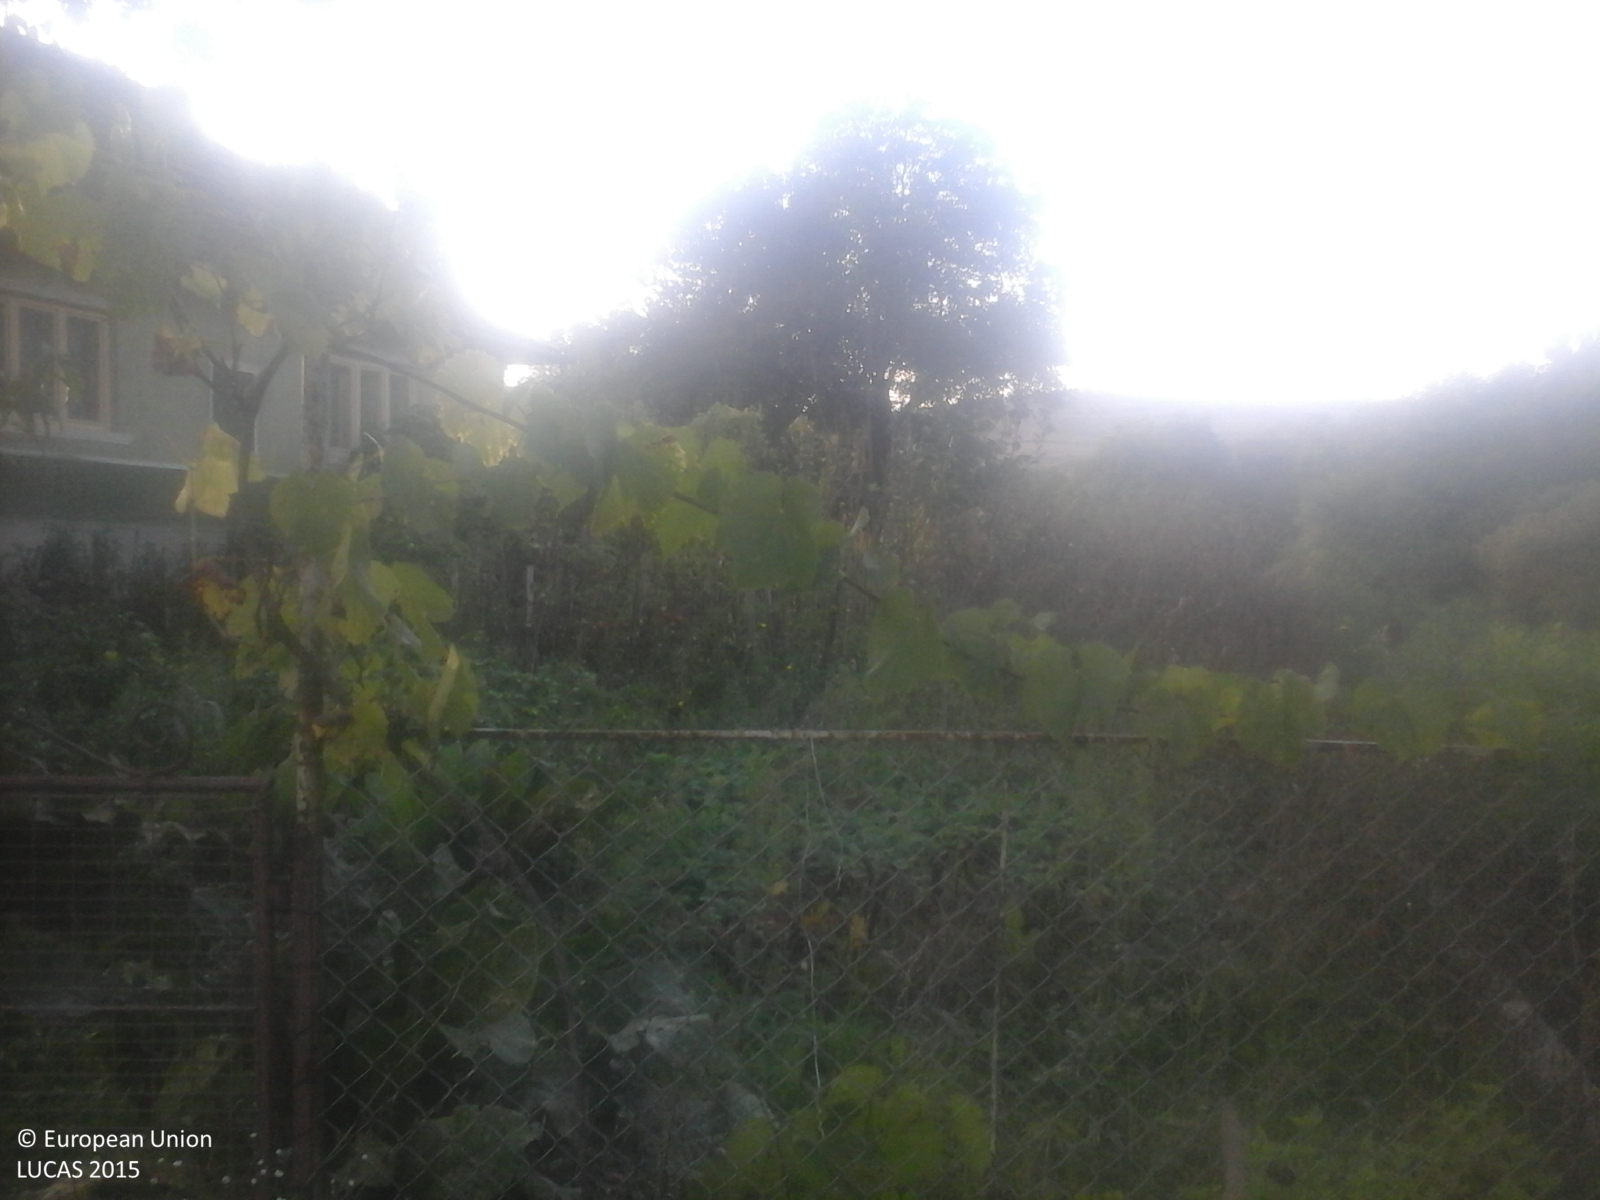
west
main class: Cropland
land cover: Apple fruit
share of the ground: 25 - 50 %
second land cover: Grassland without tree/shrub cover
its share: > 75 %
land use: Agriculture (excluding fallow land and kitchen gardens)
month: September
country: RO
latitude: 47.0745
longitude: 23.0887
